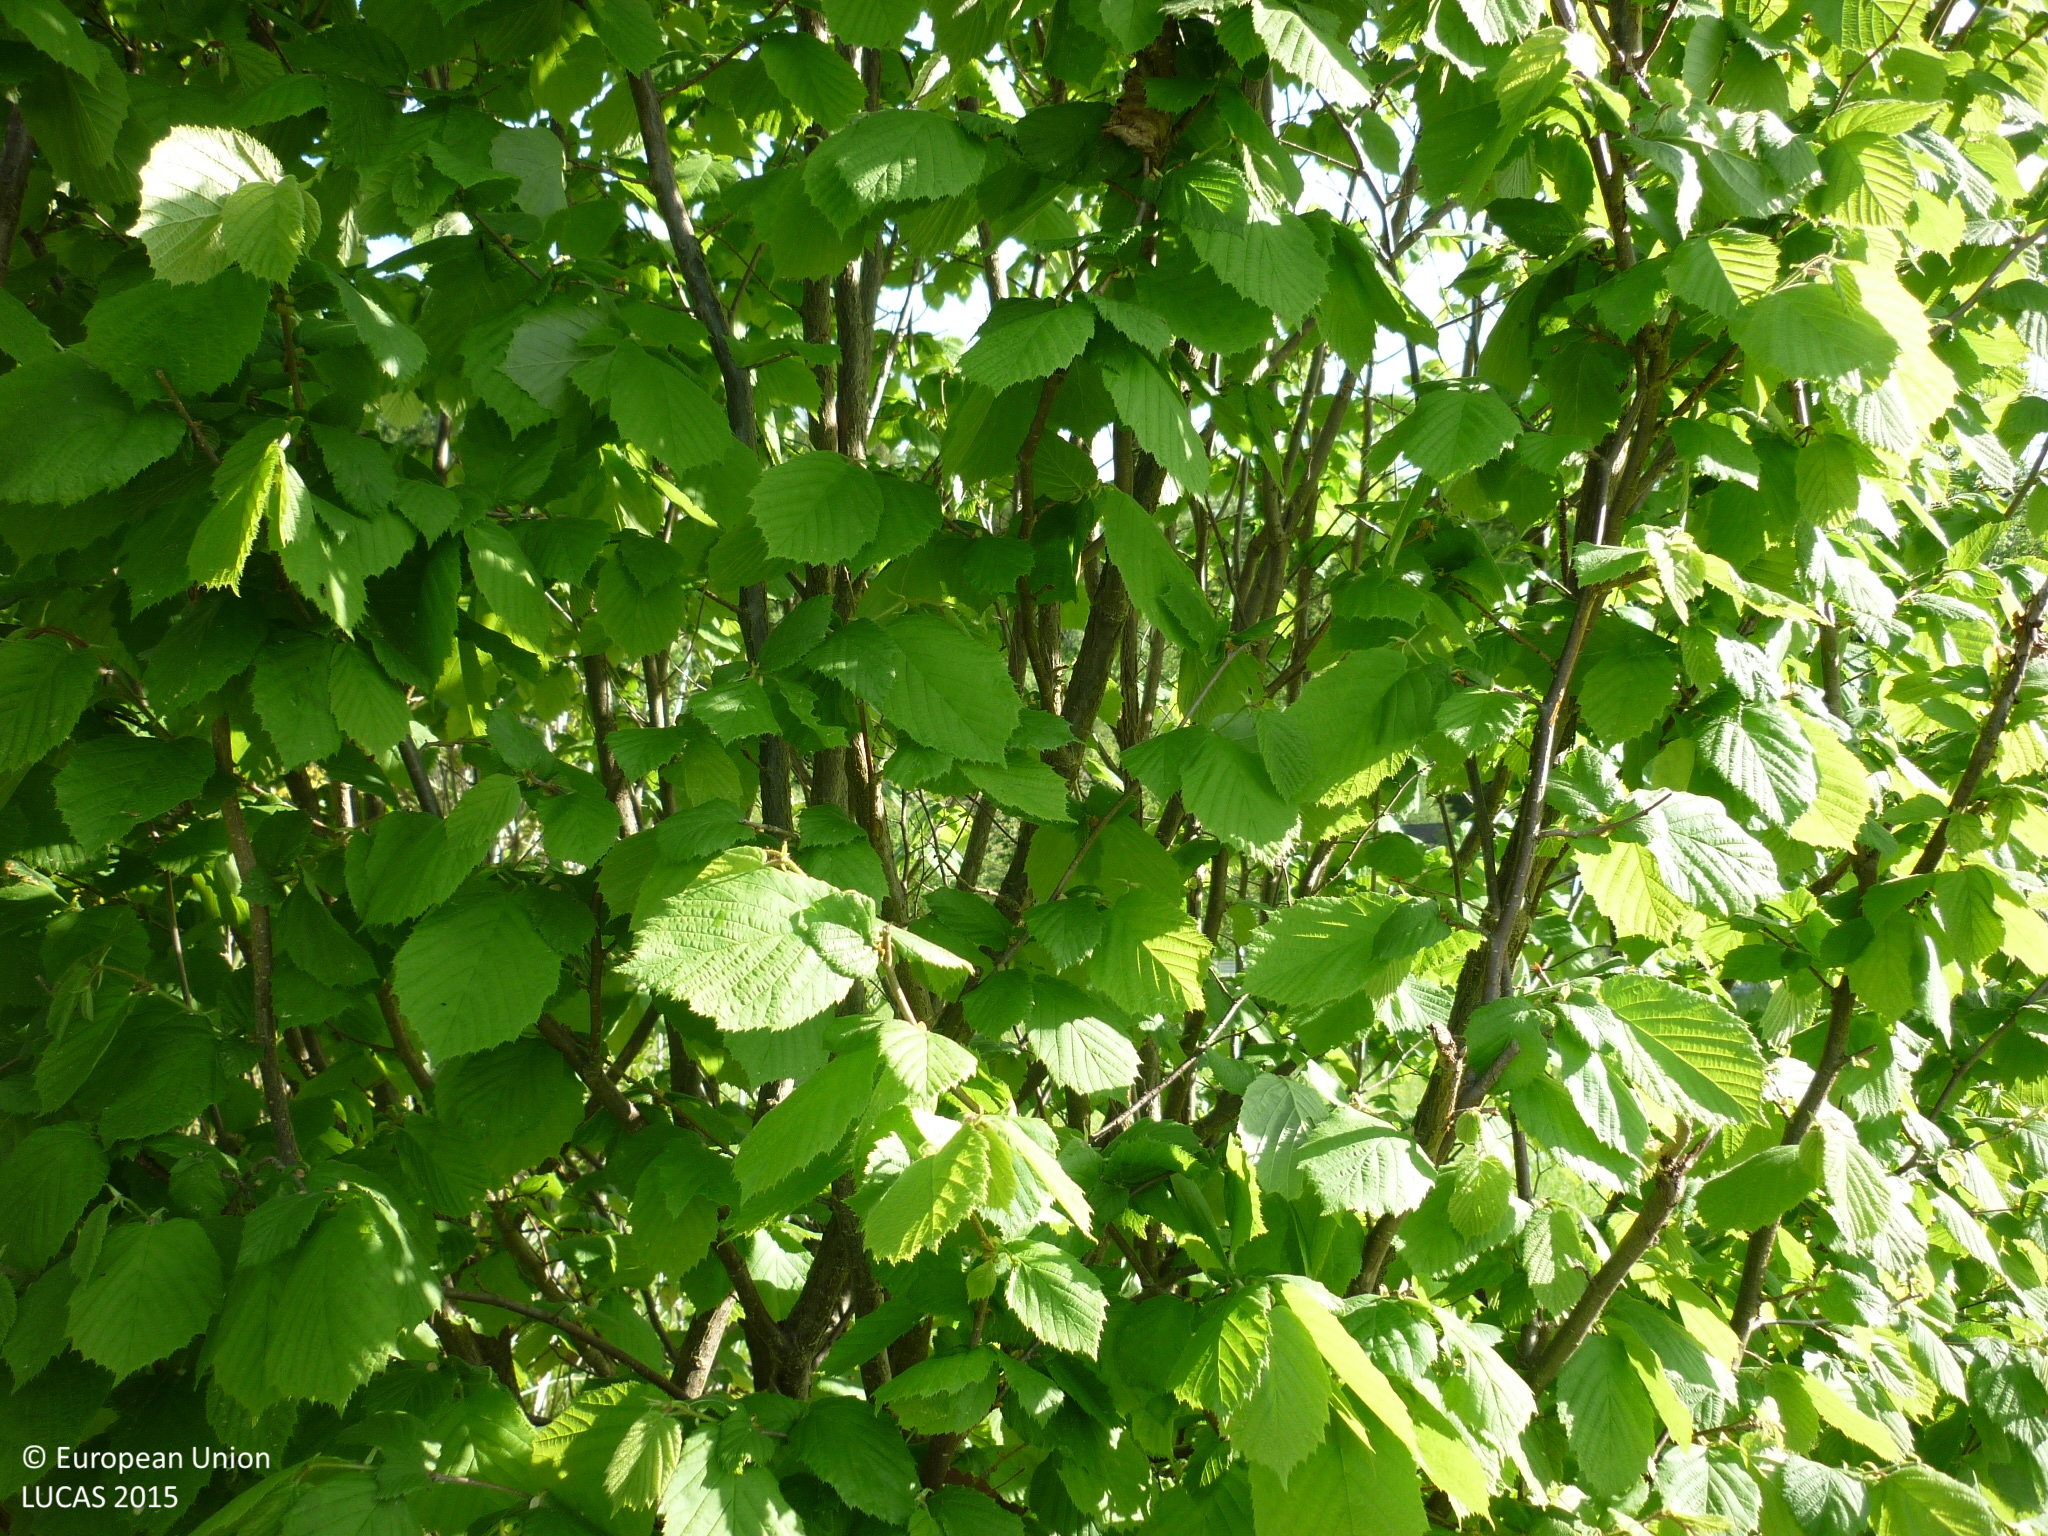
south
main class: Grassland
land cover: Grassland without tree/shrub cover
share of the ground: > 75 %
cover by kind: herbaceous plants 100 %
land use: Agriculture (excluding fallow land and kitchen gardens)
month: May
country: AT
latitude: 47.4986
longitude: 14.1007
